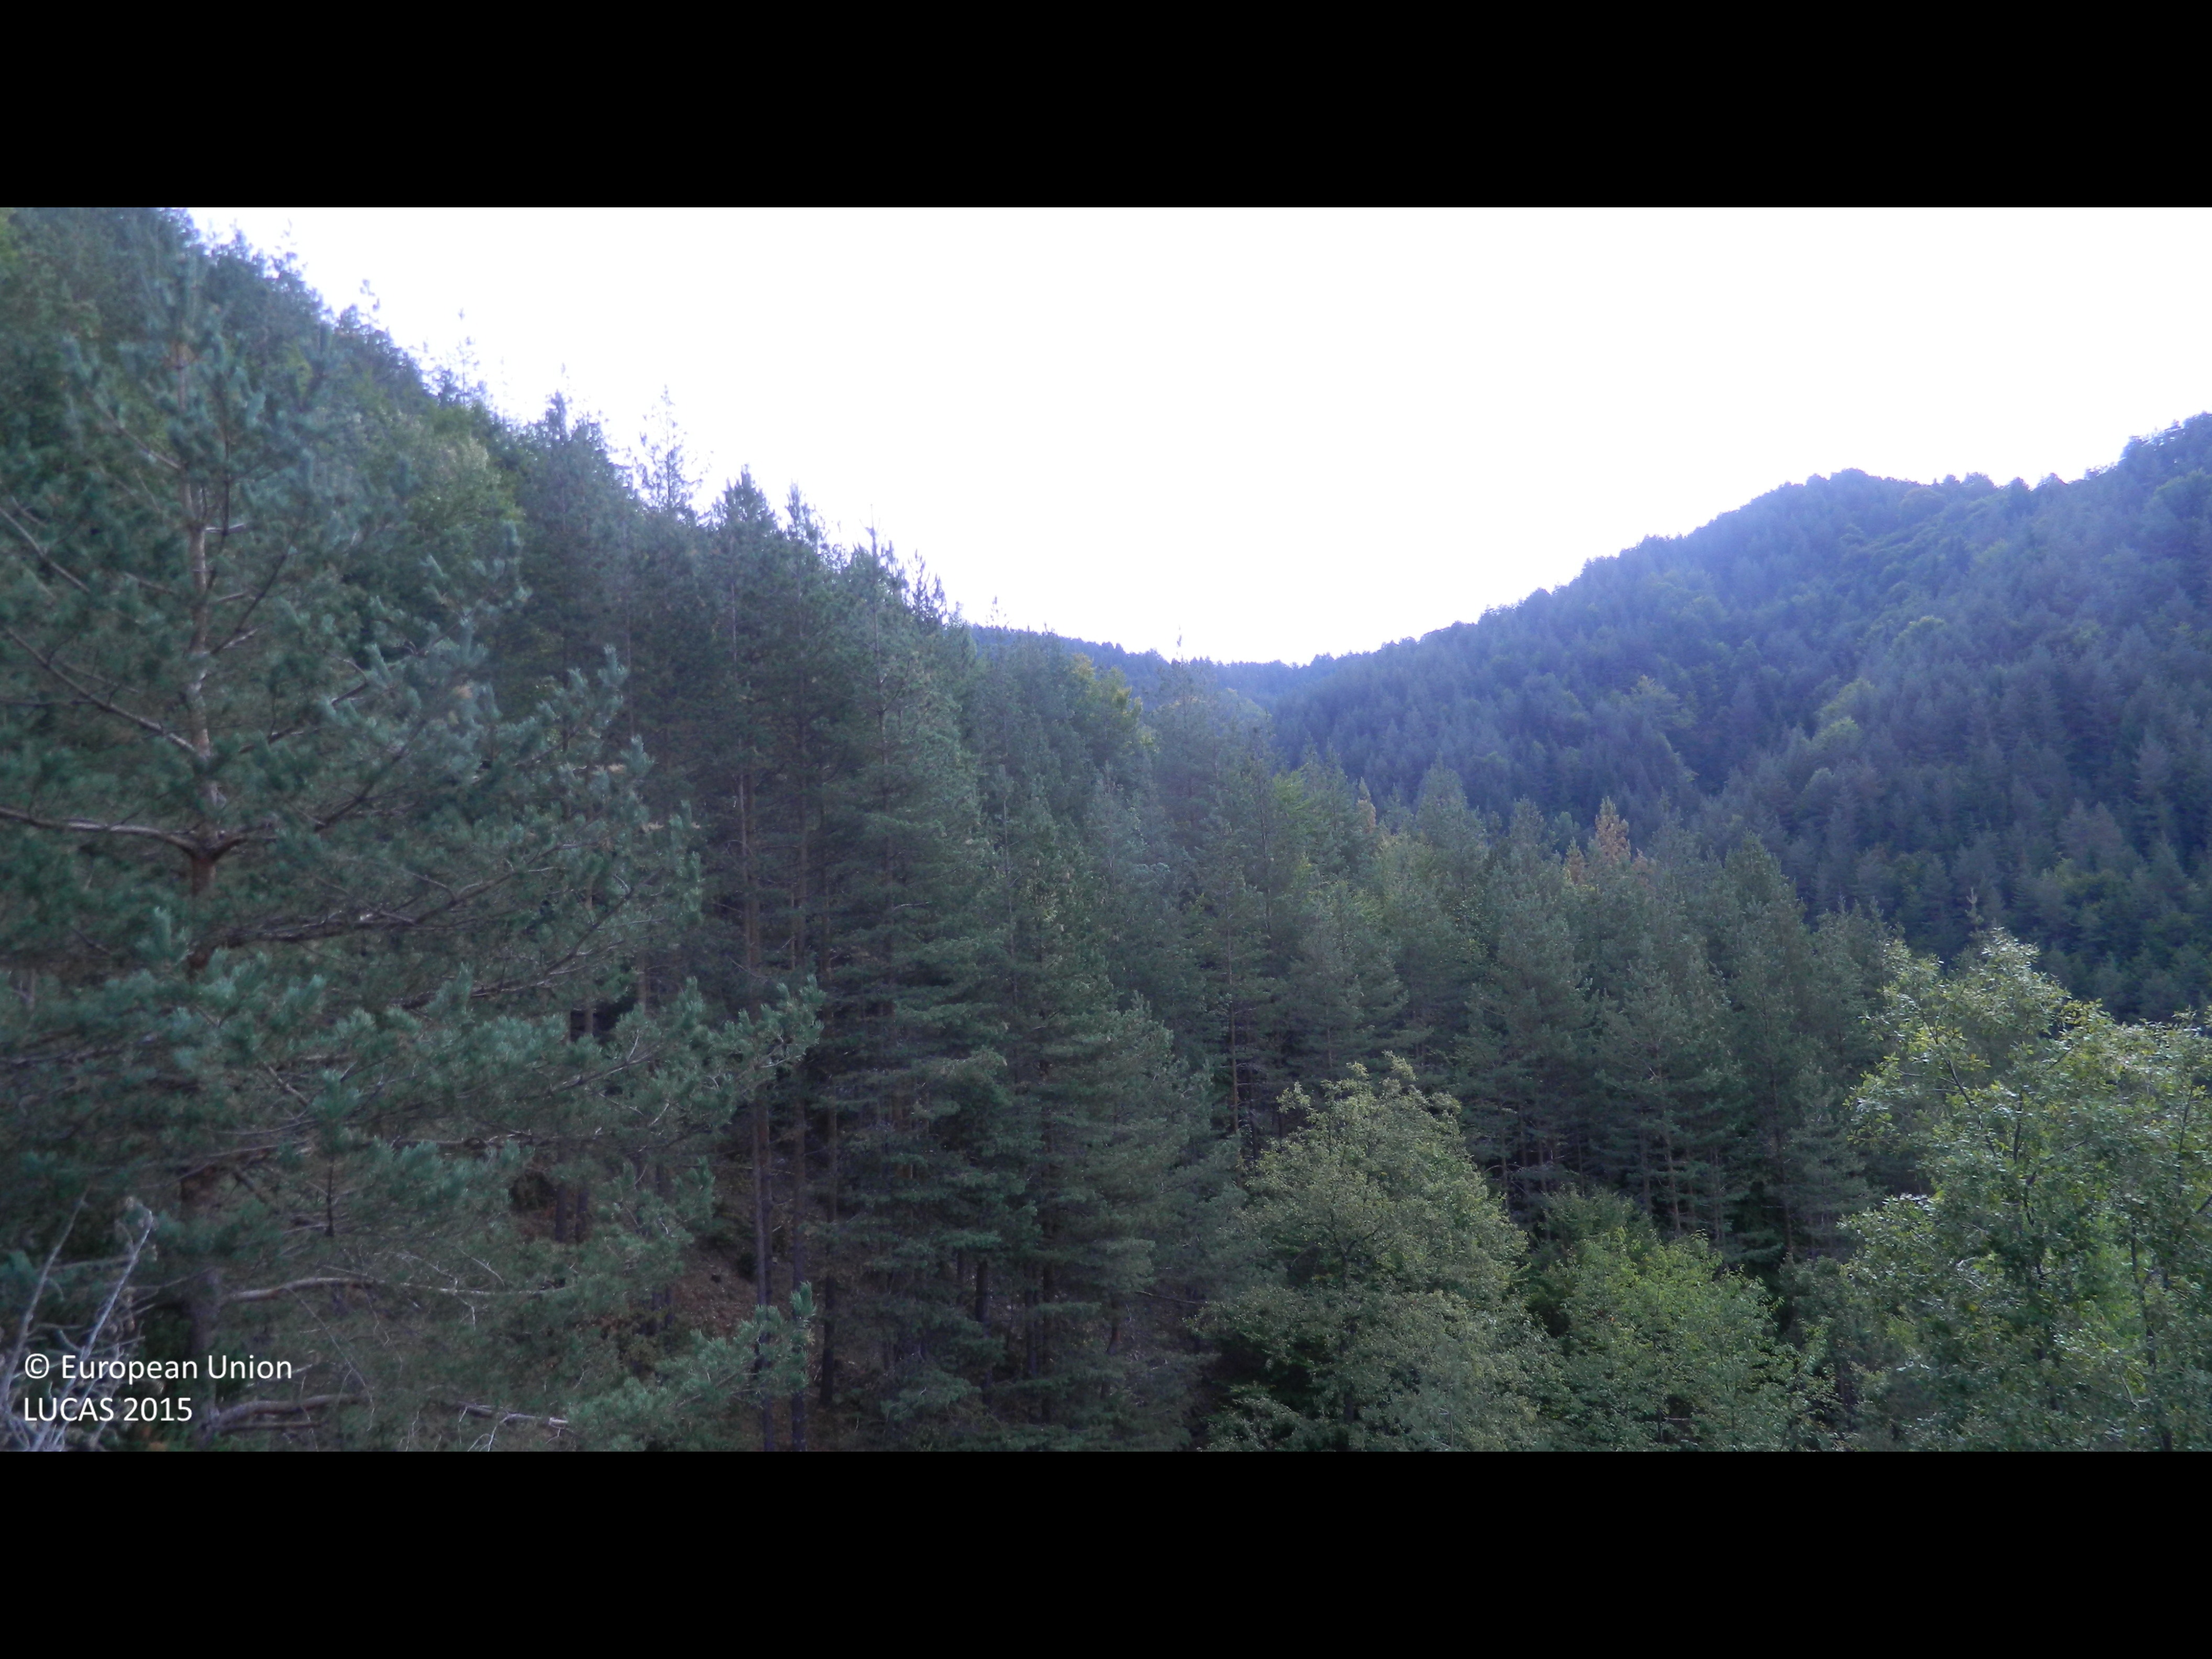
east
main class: Shrubland
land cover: Shrubland with sparse tree cover
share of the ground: > 75 %
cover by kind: herbaceous plants 80 %, shrubs 15 %, coniferous forest trees 5 %
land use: Semi-natural and natural areas not in use
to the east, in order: Shrubland with sparse tree cover; Ditches and canals; Pine dominated mixed woodland; Ditches and canals; Grassland with sparse tree/shrub cover; Grassland without tree/shrub cover; Broadleaved woodland; Shrubland with sparse tree cover
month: October
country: BG
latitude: 41.6050
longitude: 24.8656
